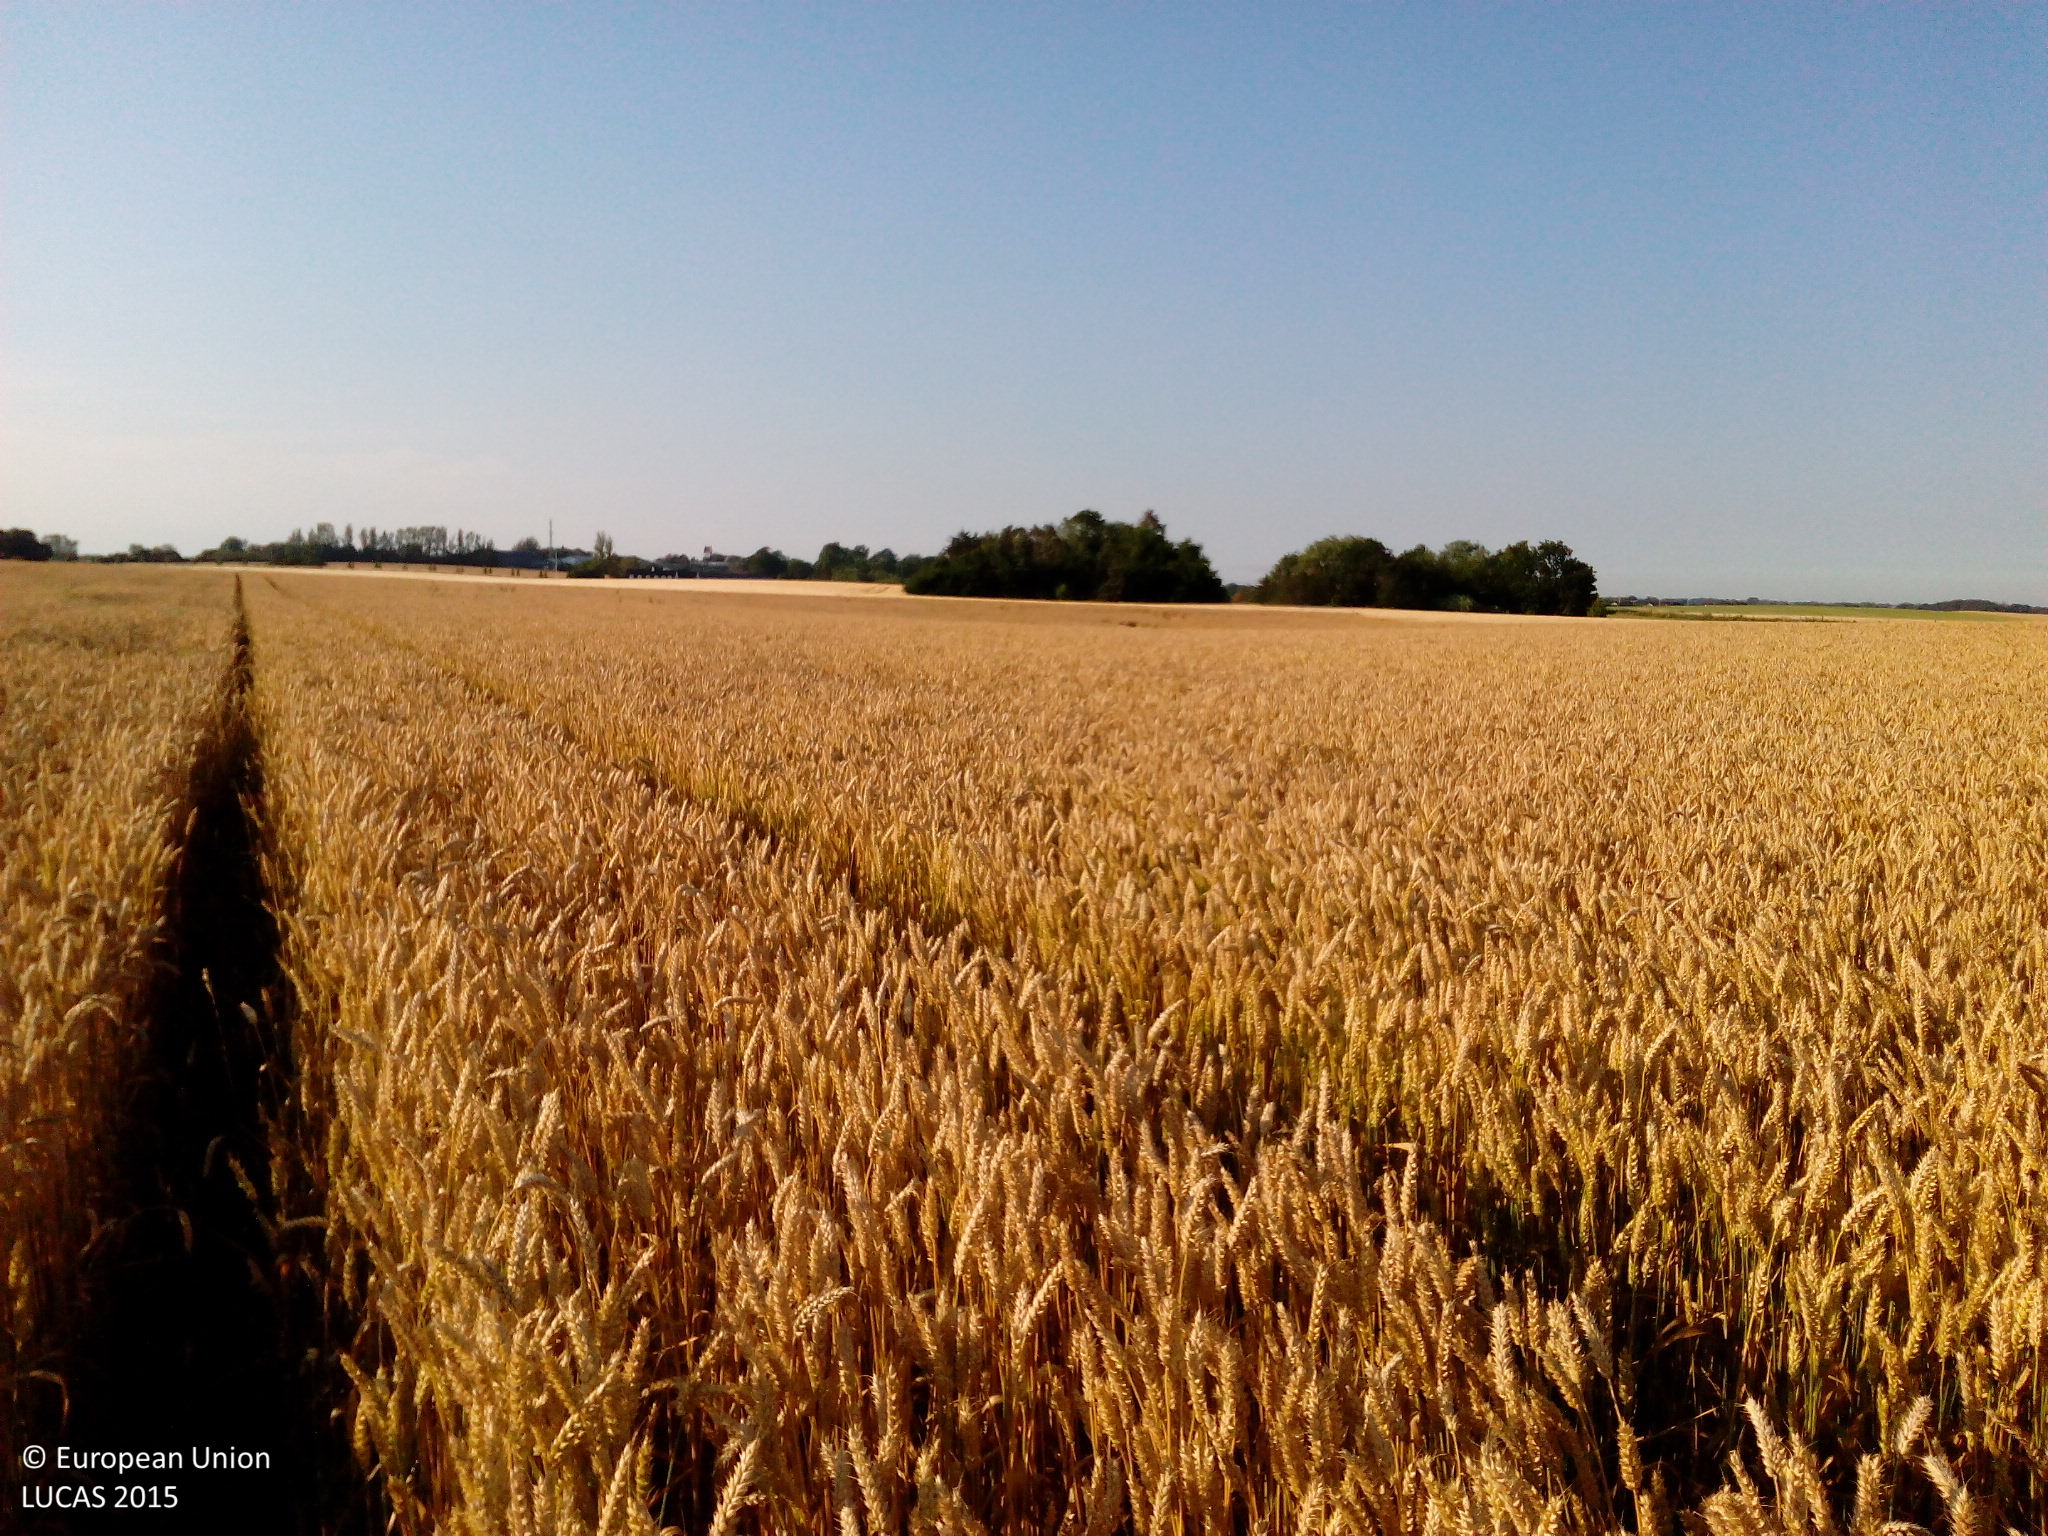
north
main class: Cropland
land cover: Common wheat
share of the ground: > 75 %
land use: Agriculture (excluding fallow land and kitchen gardens)
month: August
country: DK
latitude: 55.6884
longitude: 11.8912
